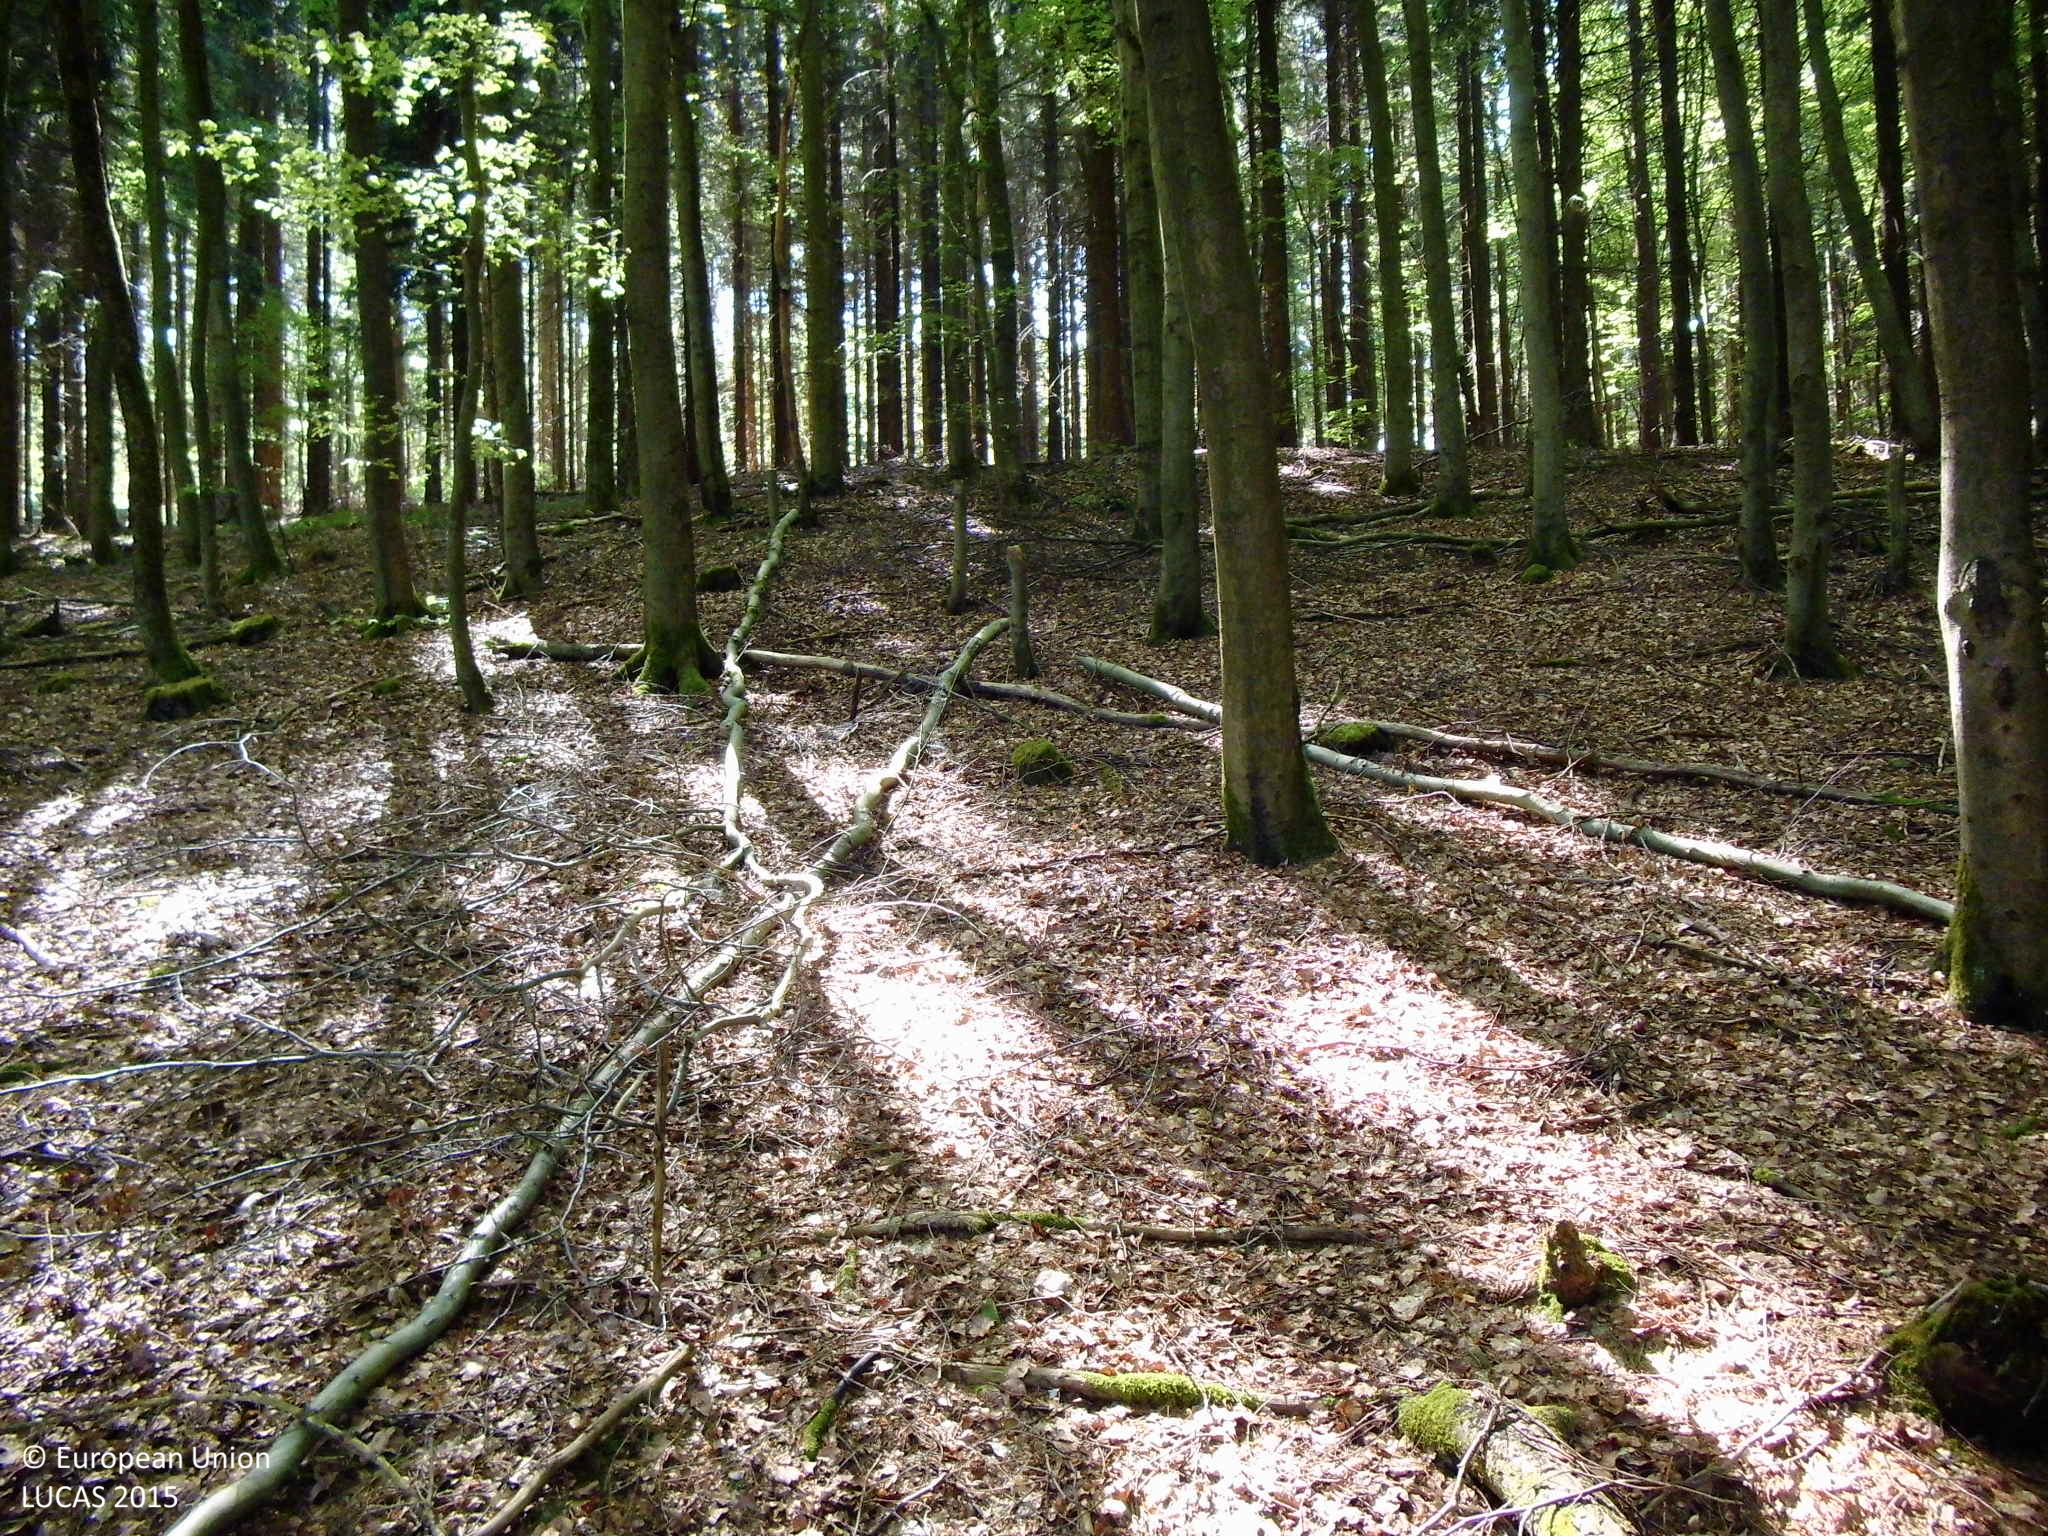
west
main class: Woodland
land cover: Spruce dominated mixed woodland
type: hemiboreal forest and nemoral coniferous forest and mixed broadleaved-coniferous forest
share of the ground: > 75 %
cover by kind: coniferous forest trees 55 %, broadleaved forest trees 45 %
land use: Forestry
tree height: > 5 m
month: June
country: DE
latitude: 50.9481
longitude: 8.5343
